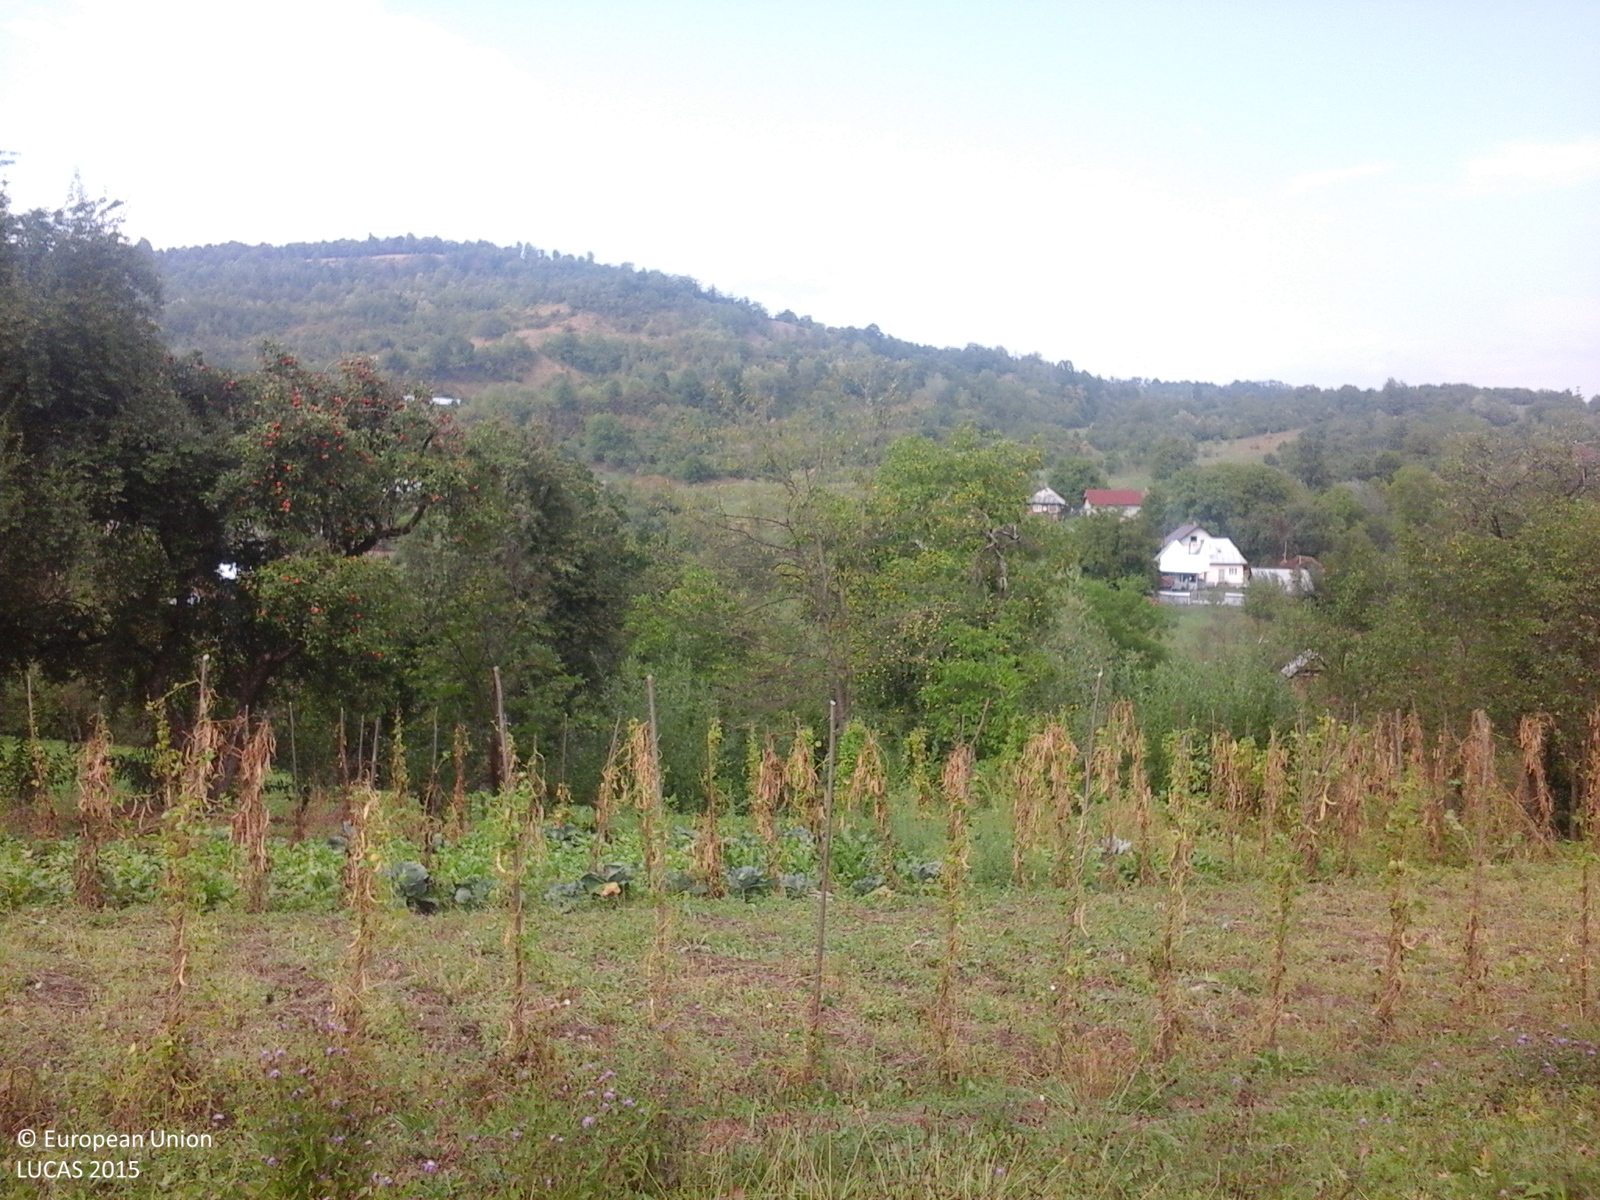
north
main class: Grassland
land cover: Grassland without tree/shrub cover
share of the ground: > 75 %
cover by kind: herbaceous plants 100 %
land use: Agriculture (excluding fallow land and kitchen gardens)
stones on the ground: < 10 %
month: September
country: RO
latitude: 47.8469
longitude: 23.9146
